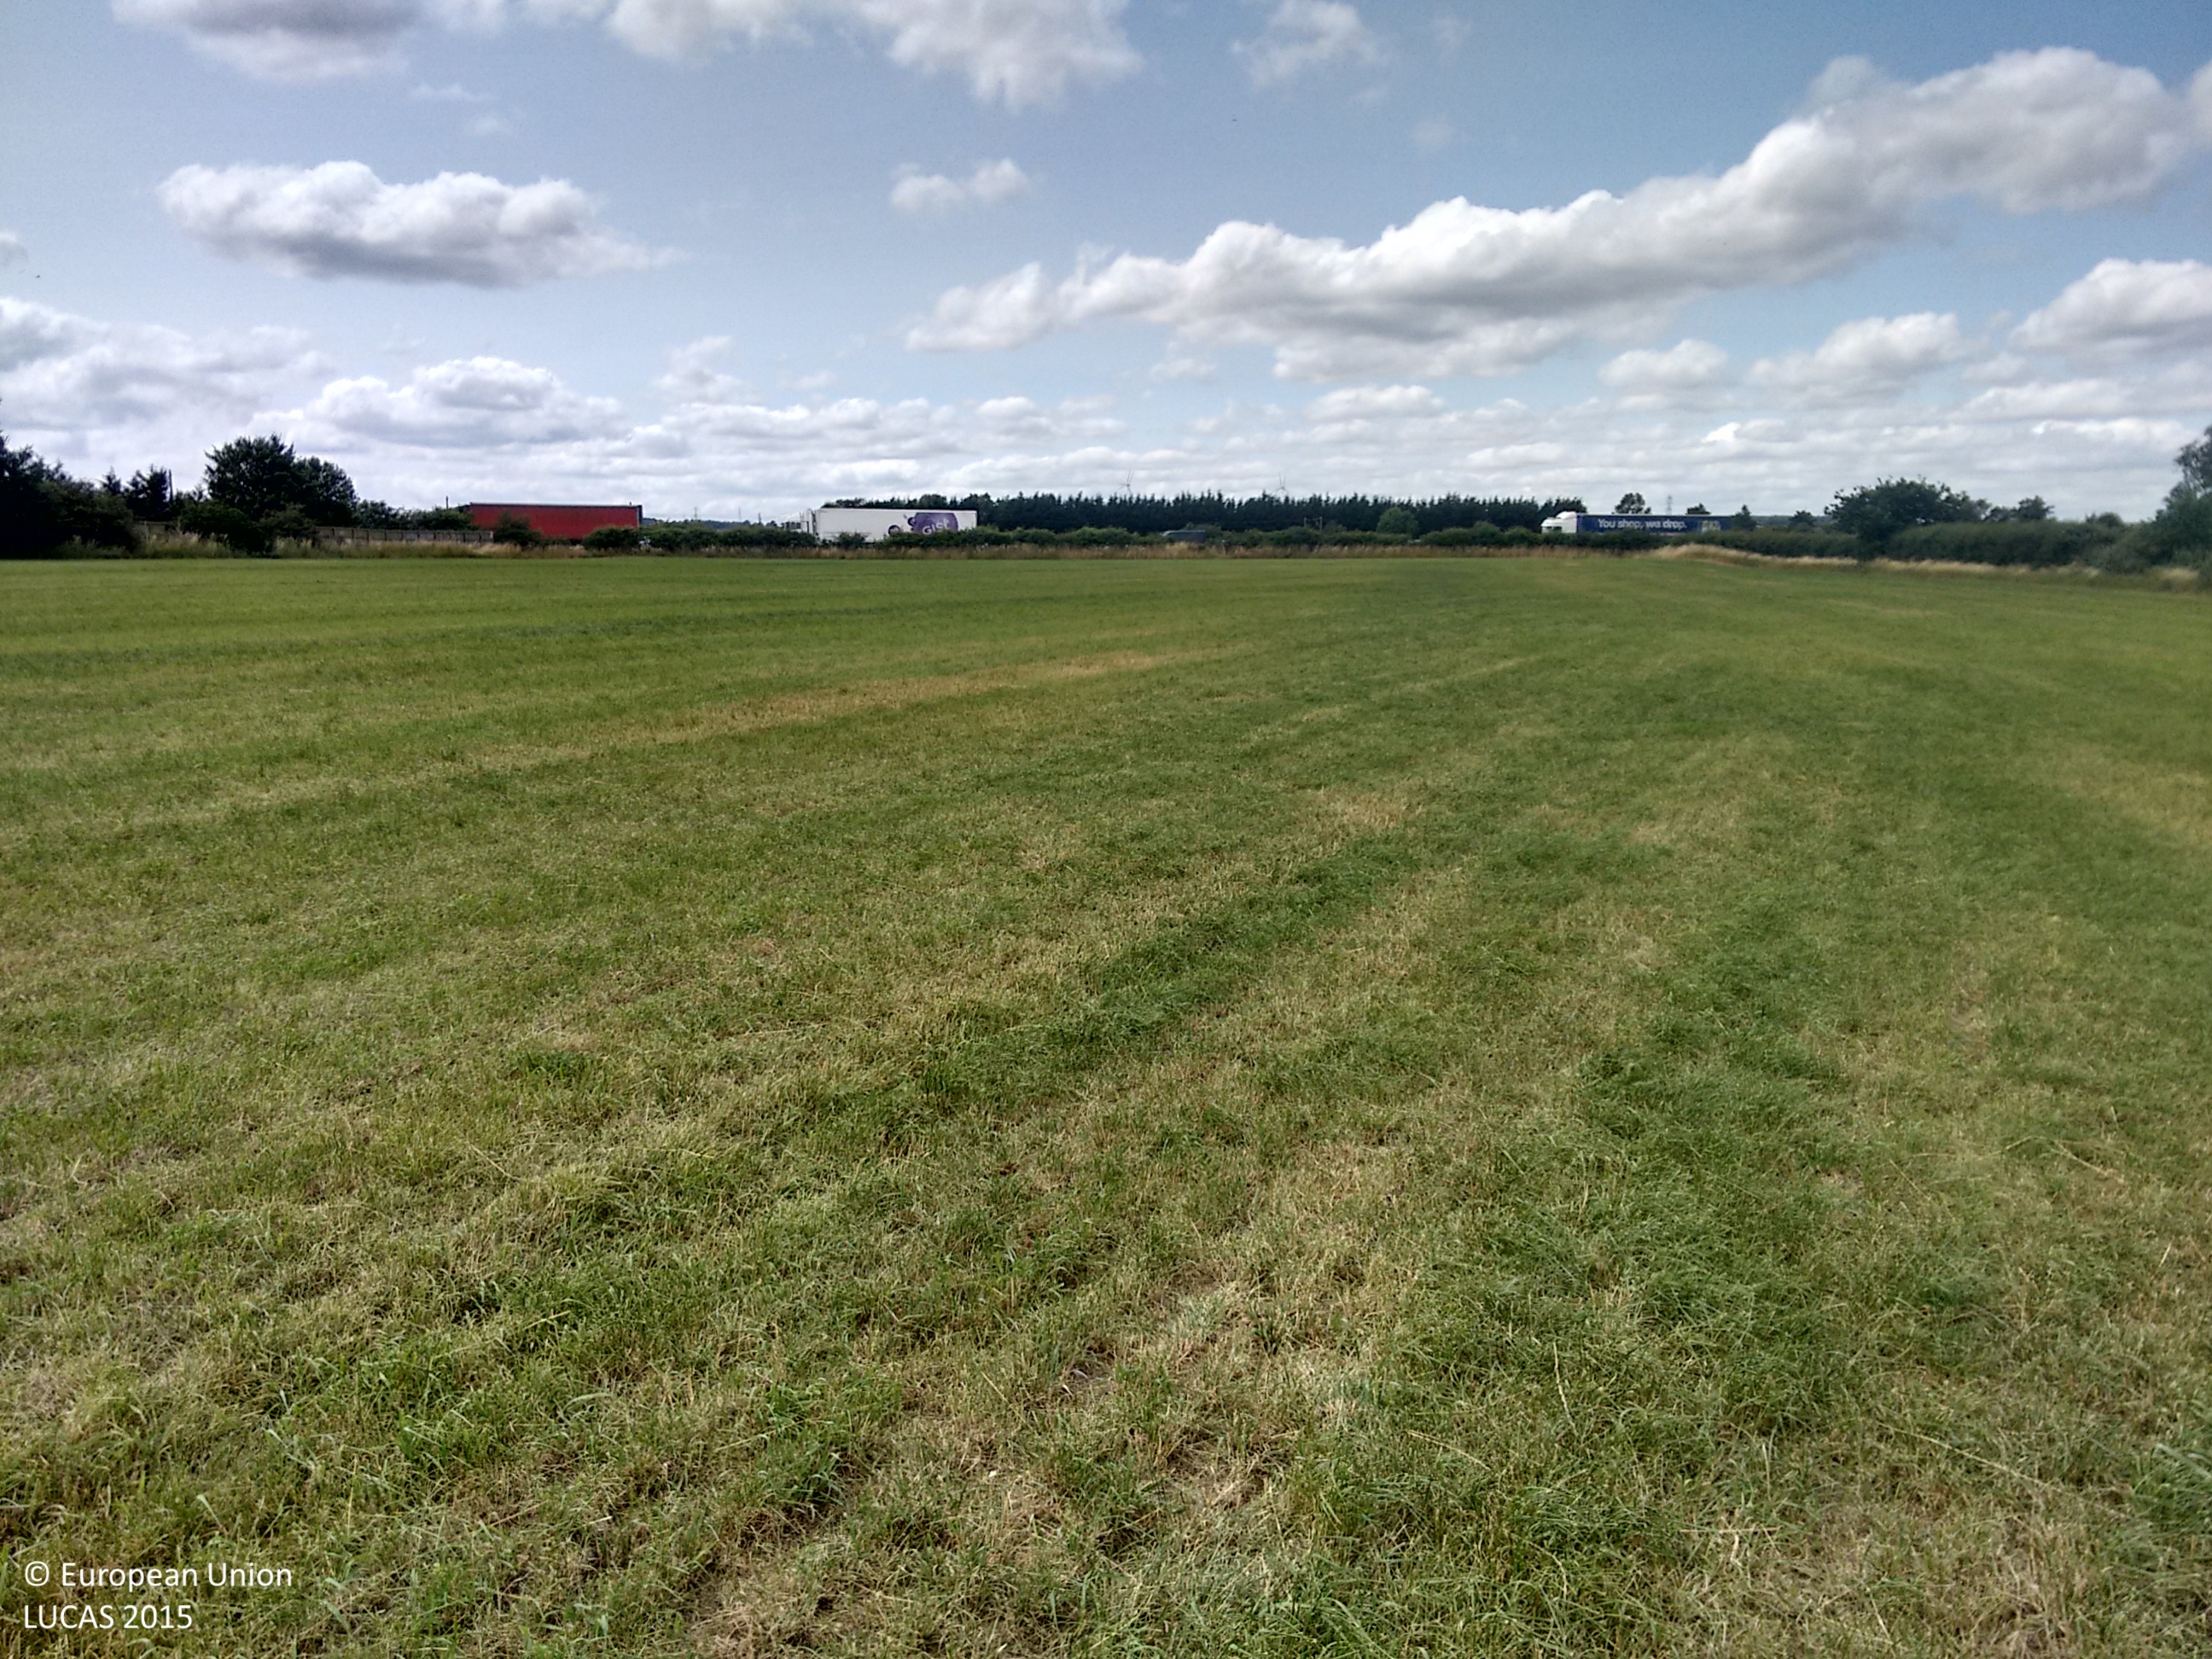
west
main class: Grassland
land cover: Grassland without tree/shrub cover
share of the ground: > 75 %
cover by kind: herbaceous plants 100 %
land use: Agriculture (excluding fallow land and kitchen gardens)
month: July
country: GB
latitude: 53.1158
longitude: -0.8136
